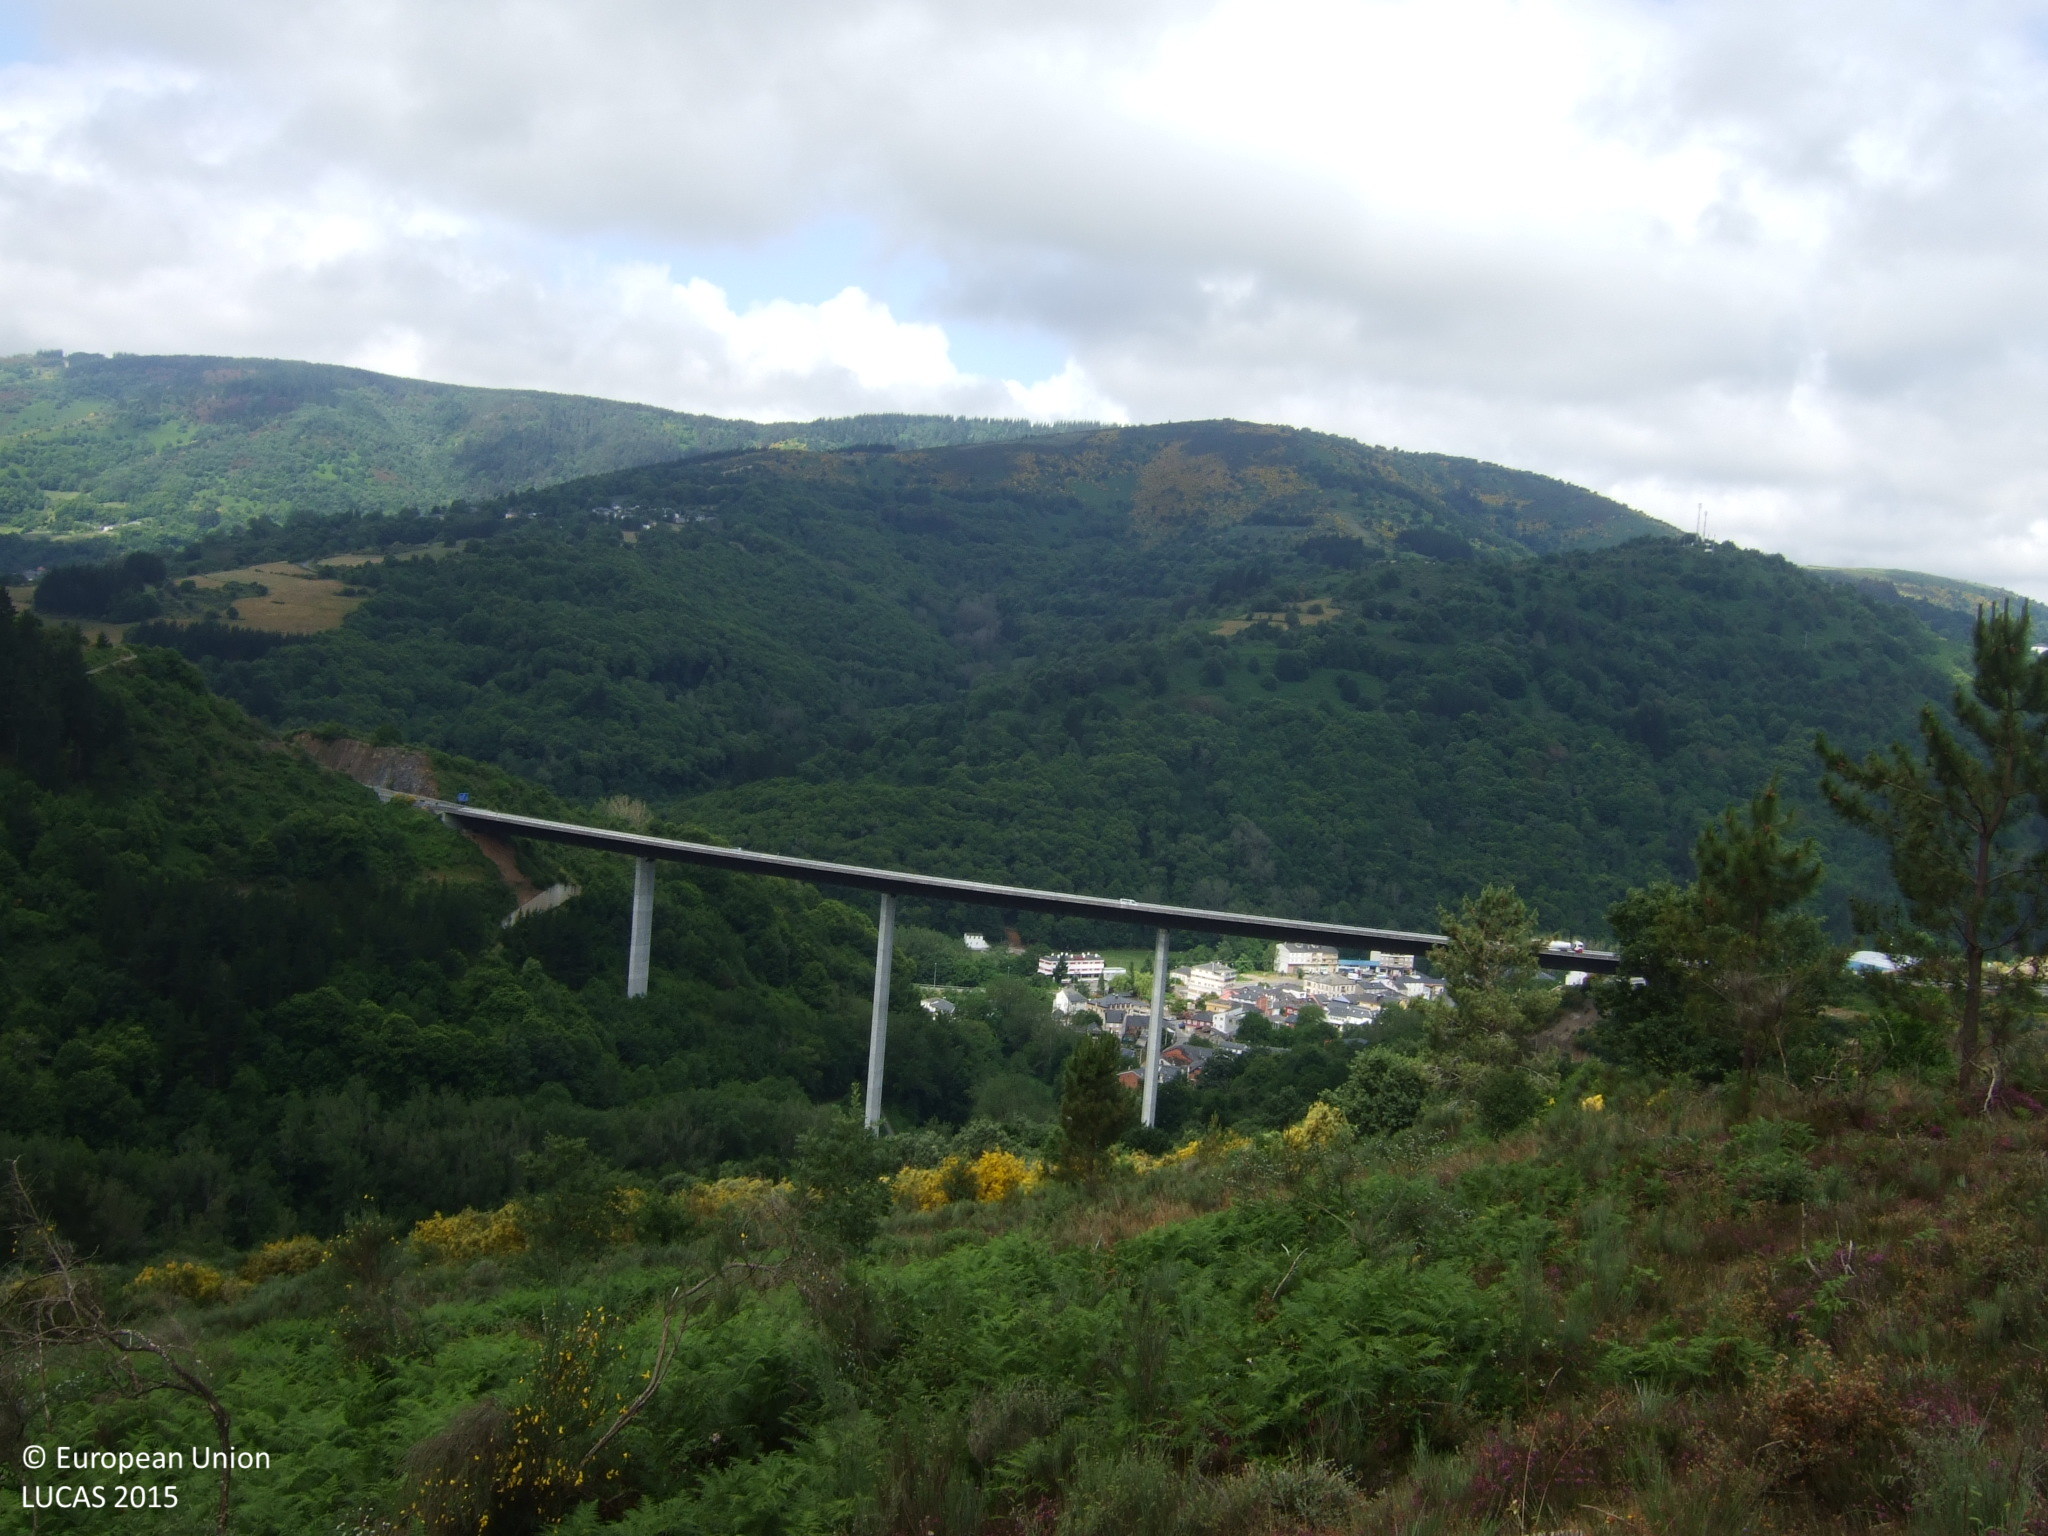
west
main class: Shrubland
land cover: Shrubland without tree cover
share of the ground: > 75 %
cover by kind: shrubs 85 %, herbaceous plants 10 %, unconsolidated bare surface 5 %
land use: Semi-natural and natural areas not in use
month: June
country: ES
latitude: 42.8083
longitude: -7.0970
